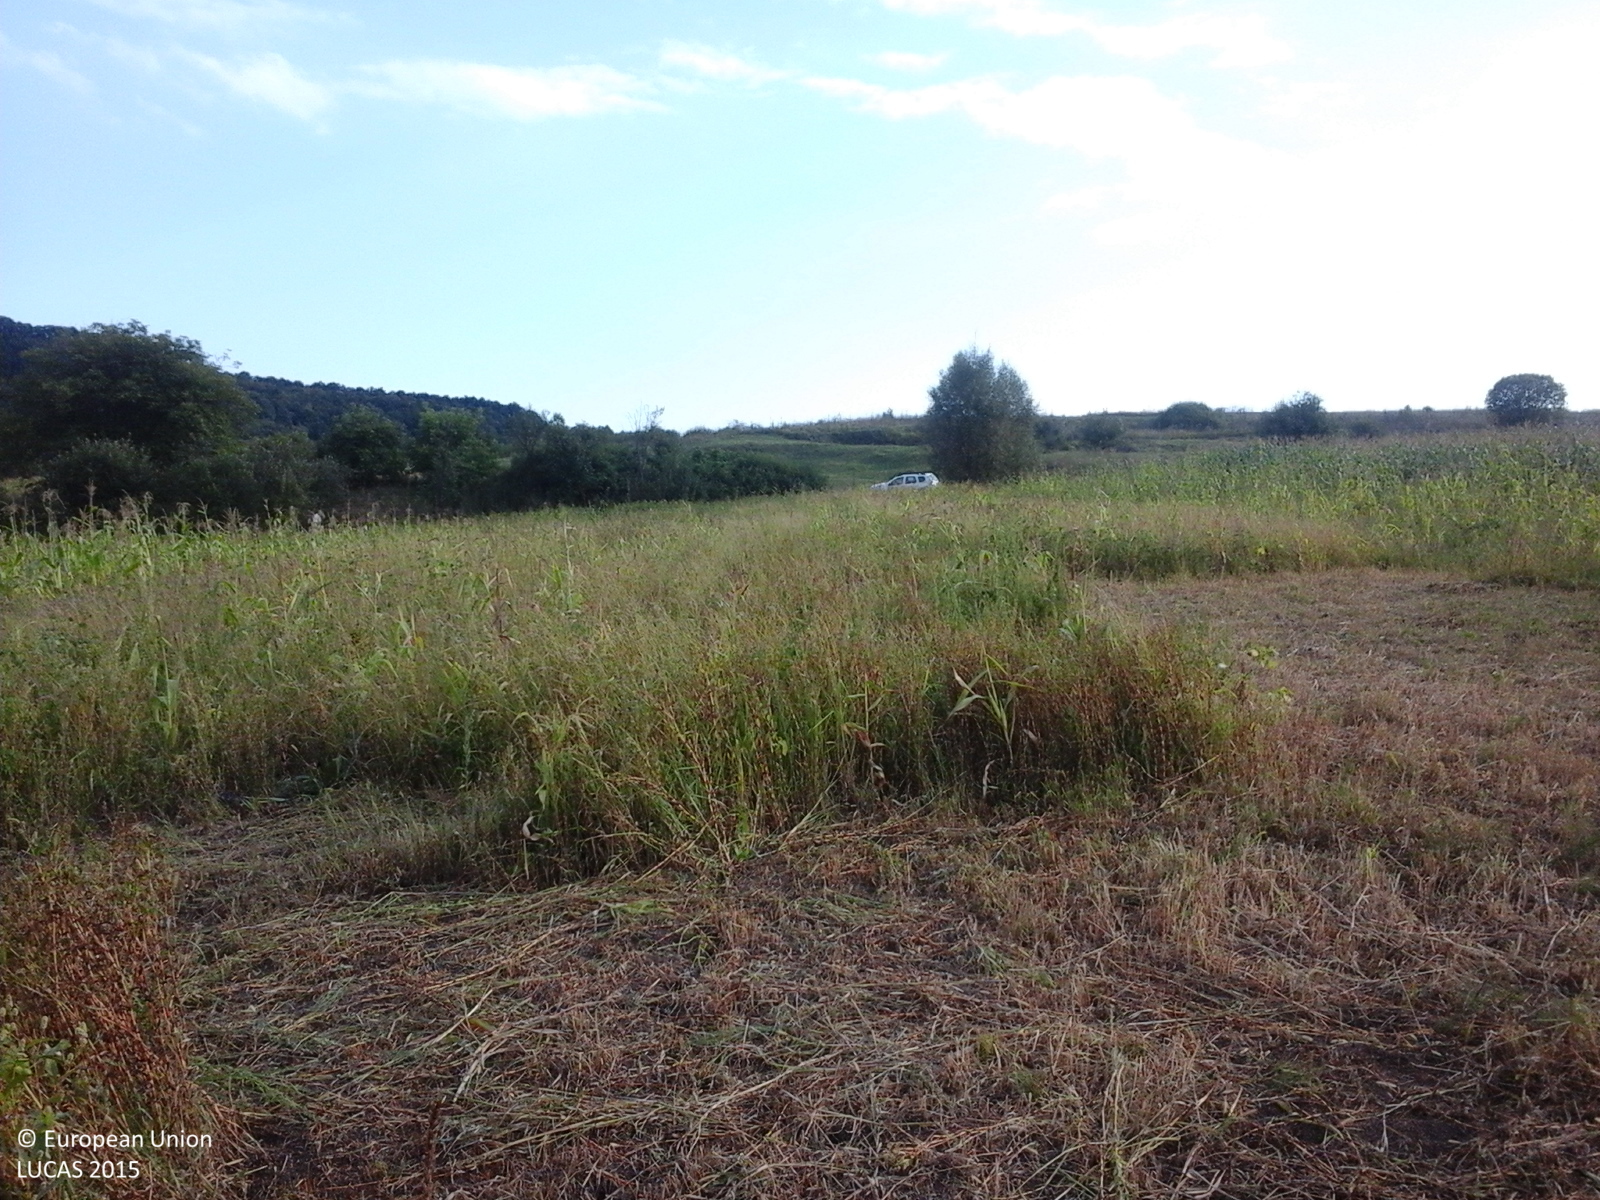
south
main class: Grassland
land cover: Grassland without tree/shrub cover
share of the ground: > 75 %
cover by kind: herbaceous plants 100 %
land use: Agriculture (excluding fallow land and kitchen gardens)
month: September
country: RO
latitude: 47.2980
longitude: 23.1994
